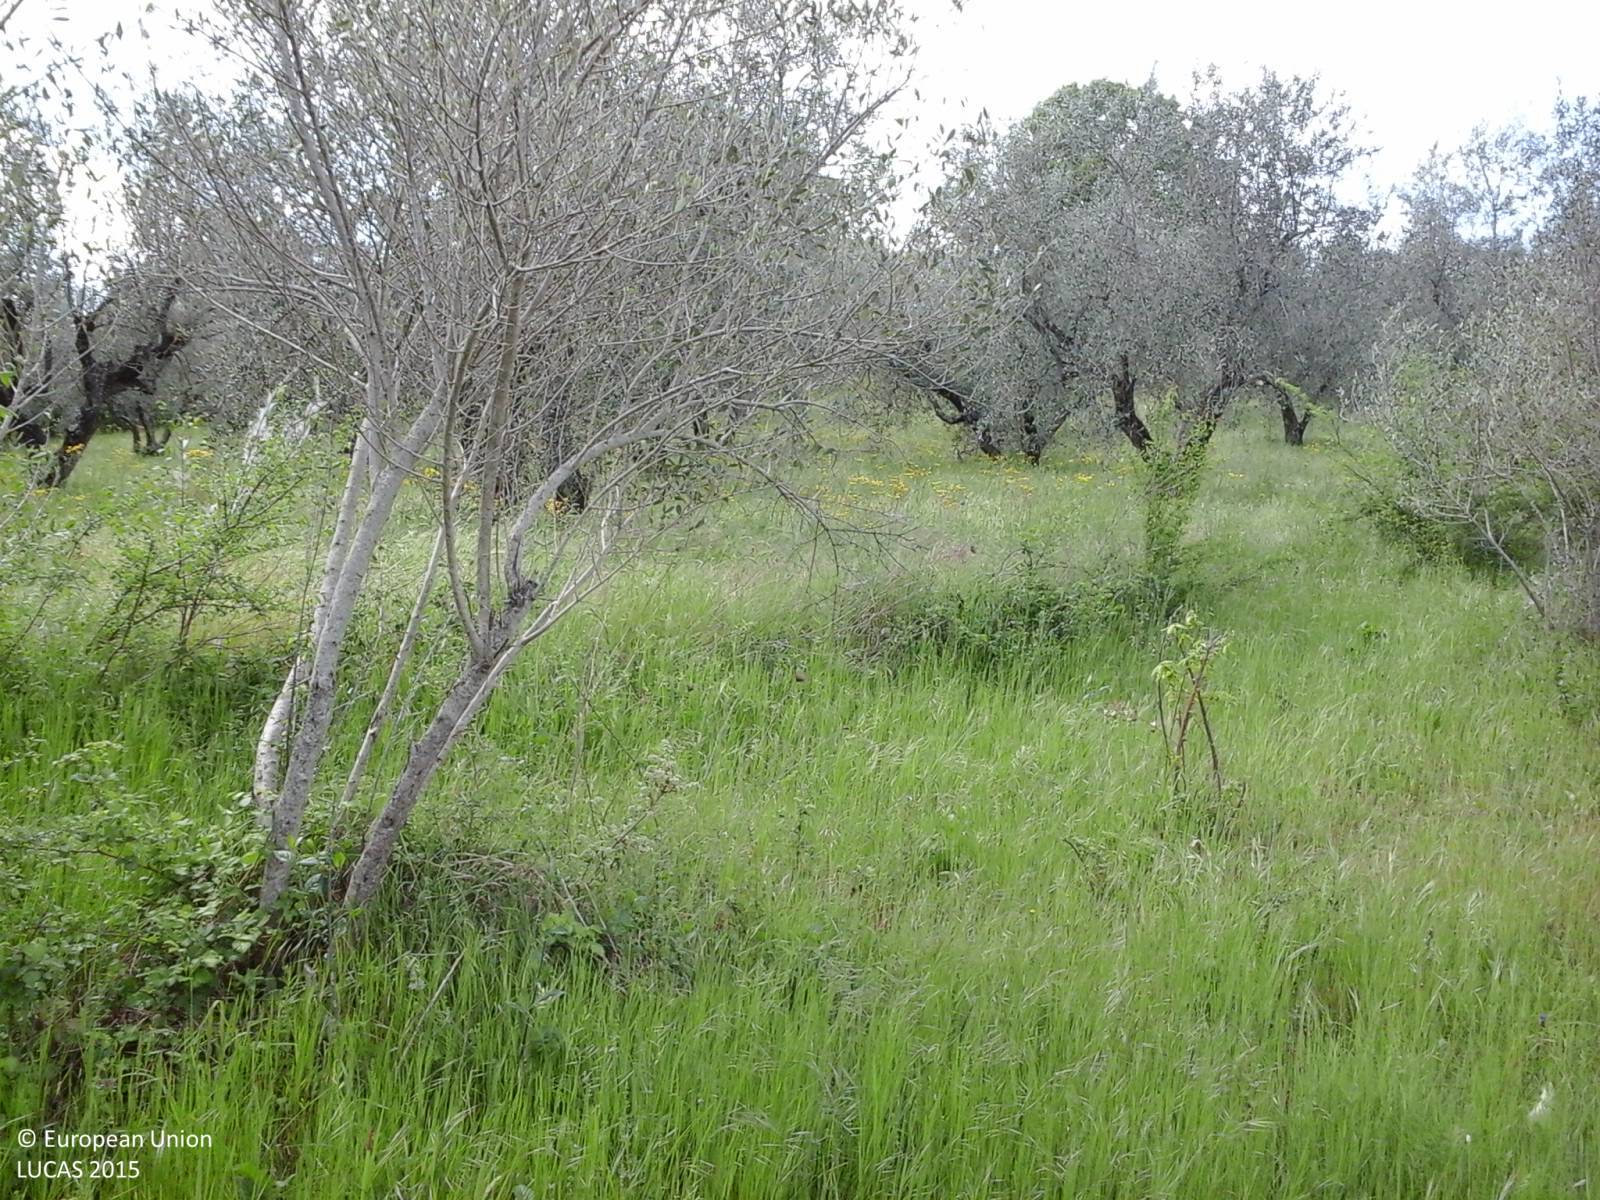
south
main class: Cropland
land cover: Olive groves
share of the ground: 25 - 50 %
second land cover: Grassland without tree/shrub cover
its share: > 75 %
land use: Agriculture (excluding fallow land and kitchen gardens)
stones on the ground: < 10 %
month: May
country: IT
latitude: 42.3614
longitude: 12.0933
